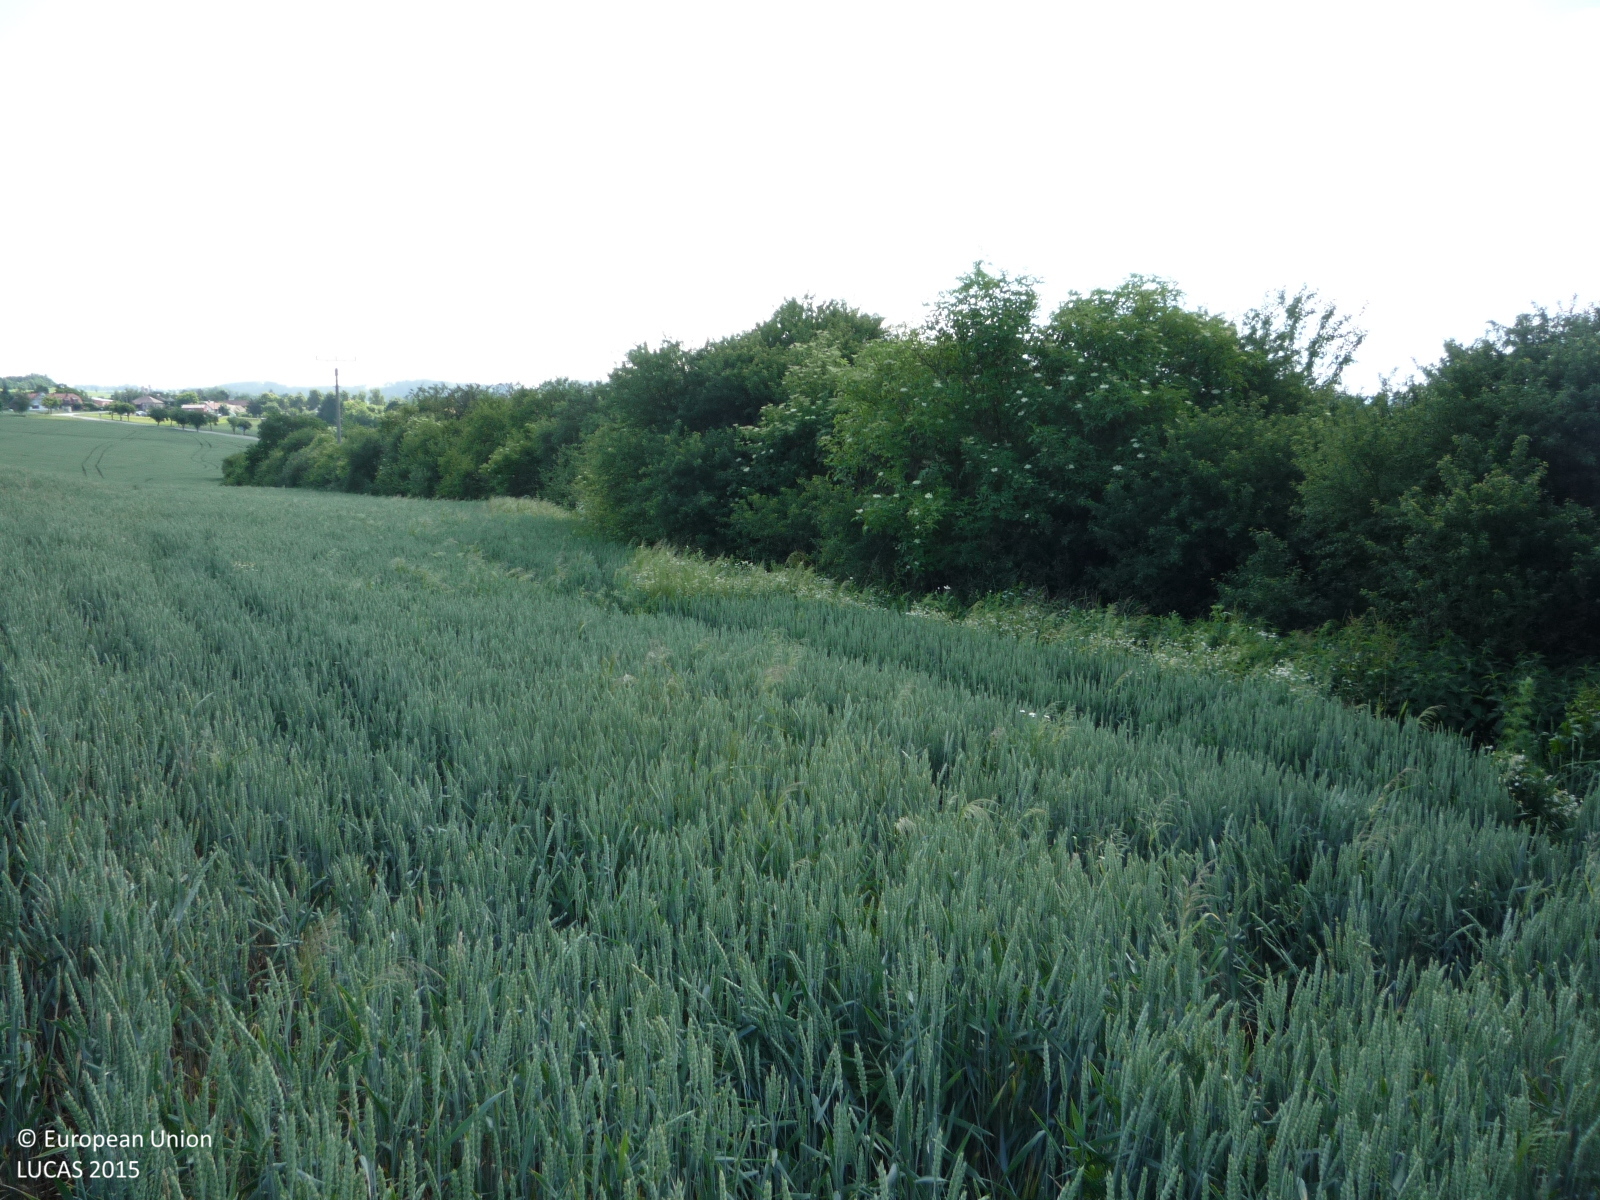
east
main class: Cropland
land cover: Common wheat
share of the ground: > 75 %
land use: Agriculture (excluding fallow land and kitchen gardens)
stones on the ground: < 10 %
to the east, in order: Common wheat; Broadleaved woodland; Electric lines; Broadleaved woodland; Common wheat; Electric lines; Common wheat
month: June
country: CZ
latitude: 49.7448
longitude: 15.1237
